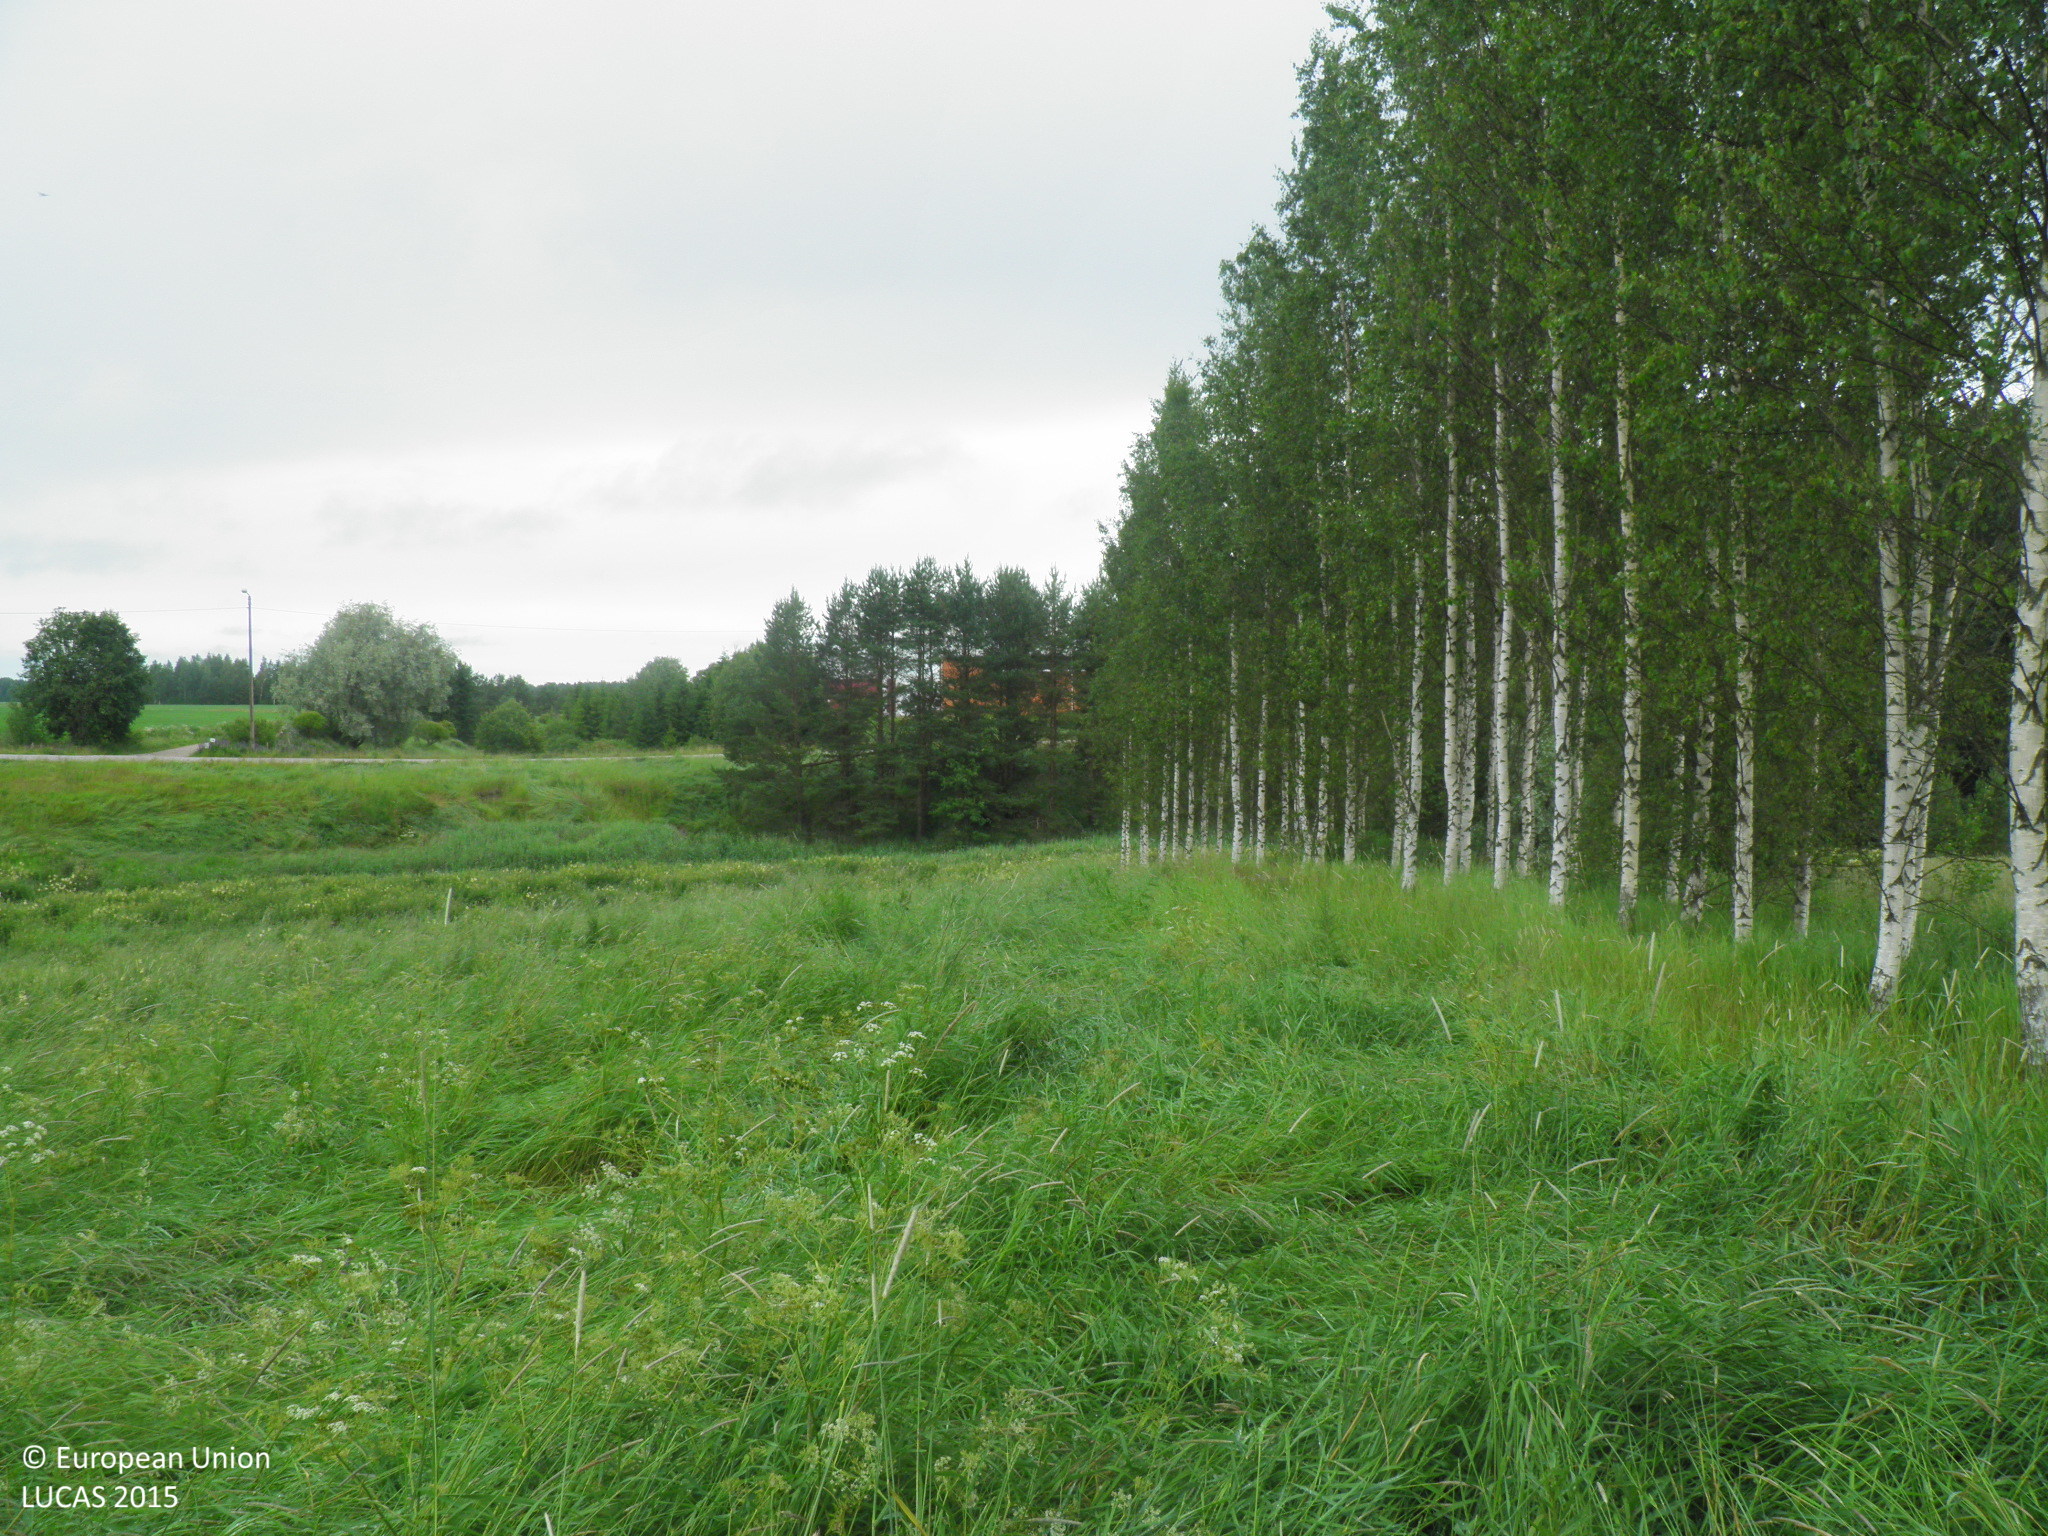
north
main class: Grassland
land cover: Grassland without tree/shrub cover
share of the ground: > 75 %
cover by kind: herbaceous plants 100 %
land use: Agriculture (excluding fallow land and kitchen gardens)
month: July
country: FI
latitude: 60.6203
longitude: 22.7735
